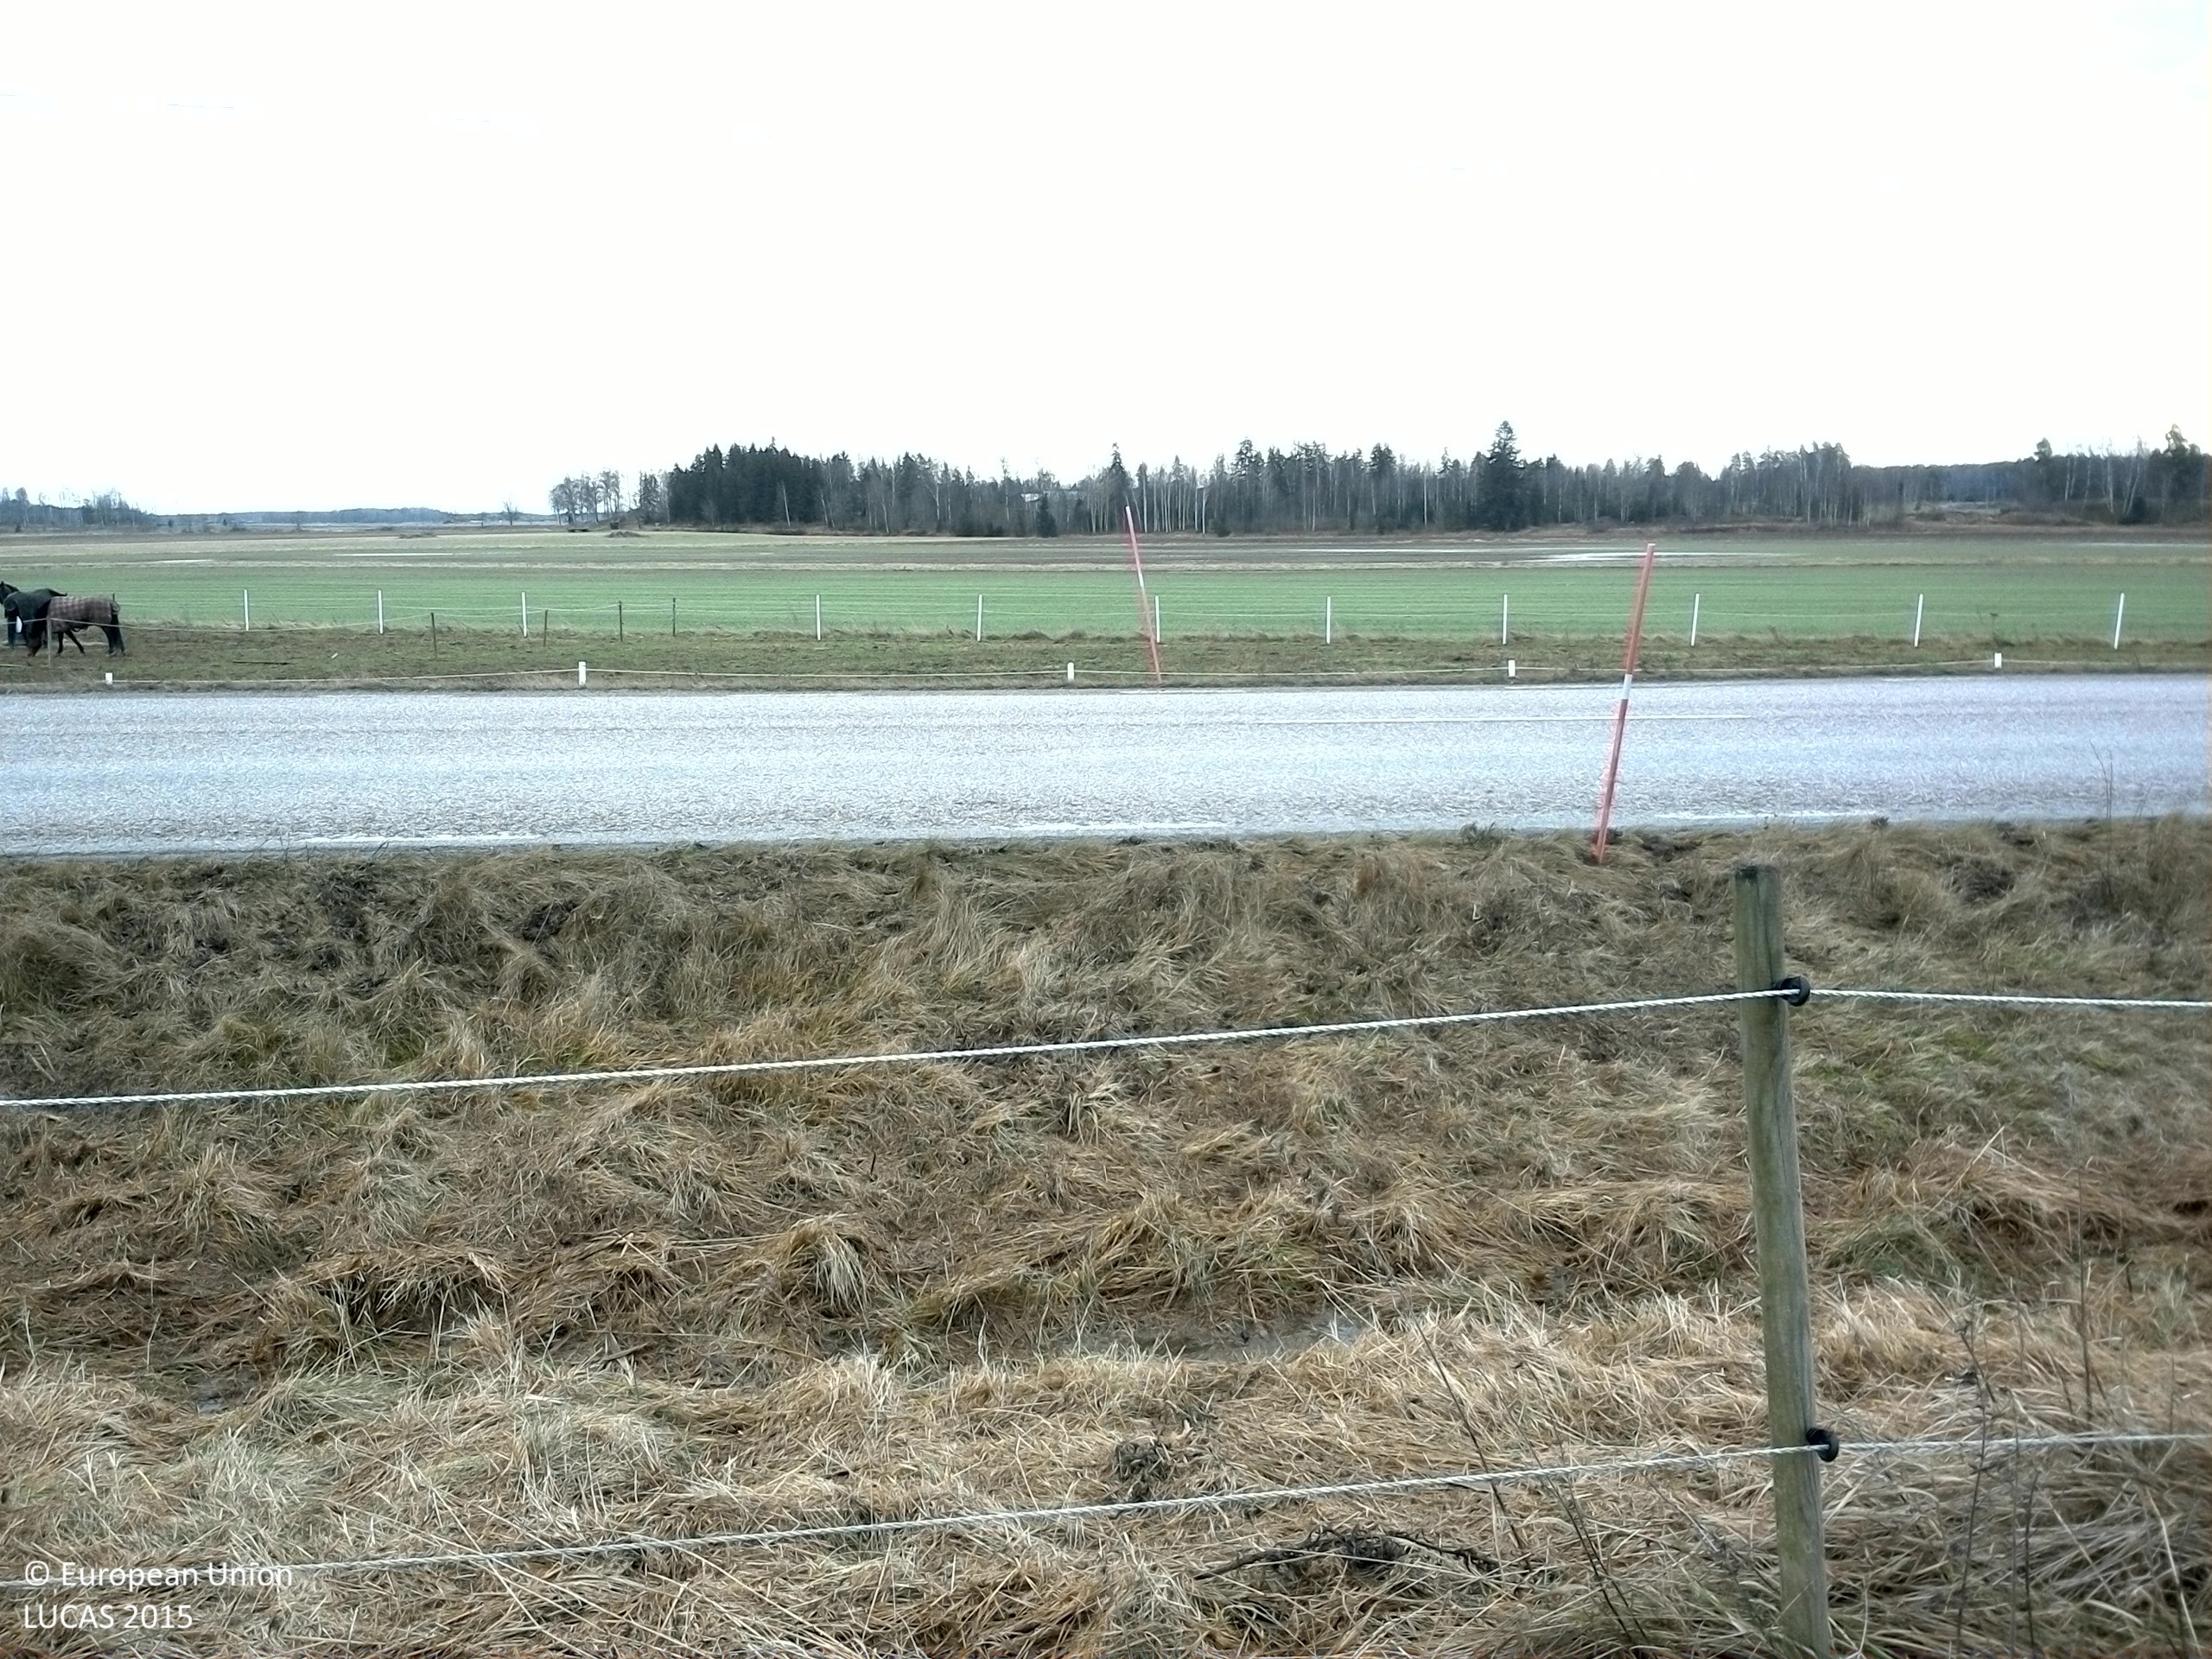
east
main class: Grassland
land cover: Grassland without tree/shrub cover
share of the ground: > 75 %
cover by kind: herbaceous plants 100 %
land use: Agriculture (excluding fallow land and kitchen gardens)
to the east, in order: Grassland without tree/shrub cover; Fences; Grass margins; Ditches and canals; Grass margins; Paved roads, cycling and walking lanes; Grassland without tree/shrub cover; Single bushes/trees; Electric lines; Grass margins; Fences; Grassland without tree/shrub cover; Fences; Grass margins; Common wheat
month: December
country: SE
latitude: 59.6429
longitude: 16.6801
